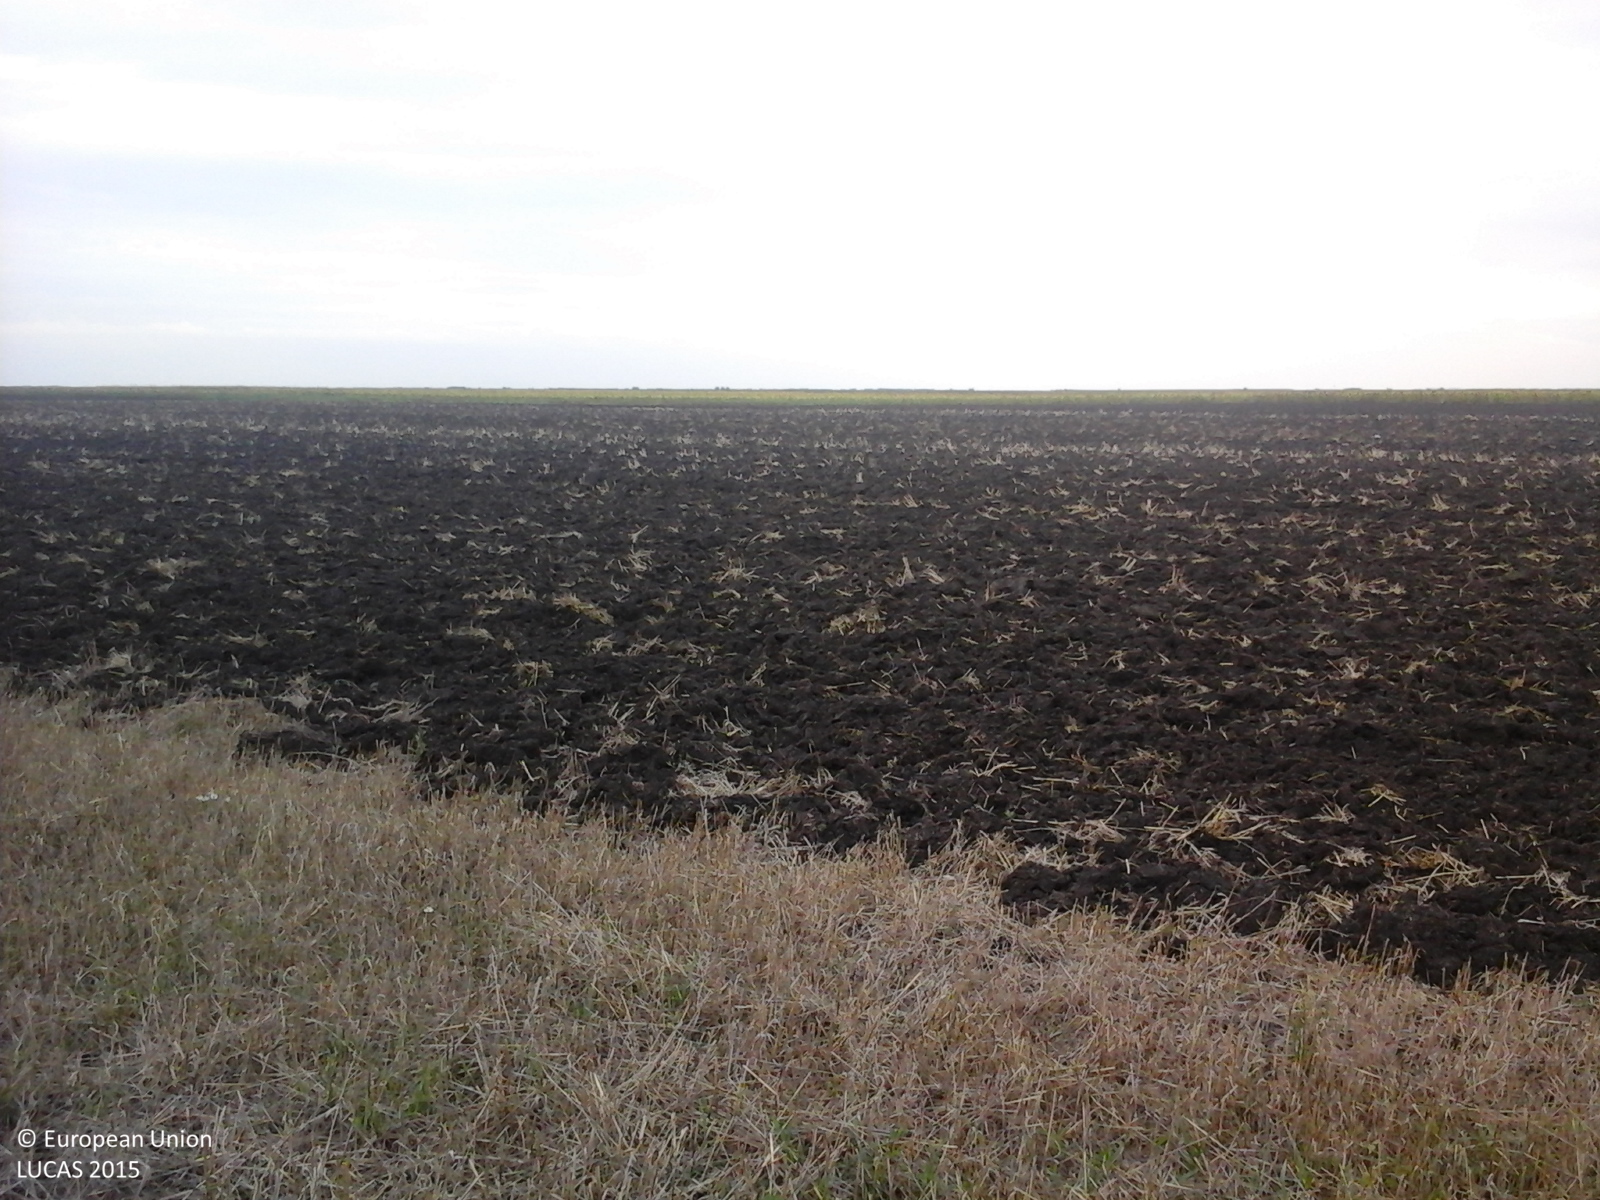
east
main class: Cropland
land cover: Durum wheat
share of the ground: 25 - 50 %
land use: Agriculture (excluding fallow land and kitchen gardens)
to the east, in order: Durum wheat
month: August
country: RO
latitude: 46.0325
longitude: 20.5024
